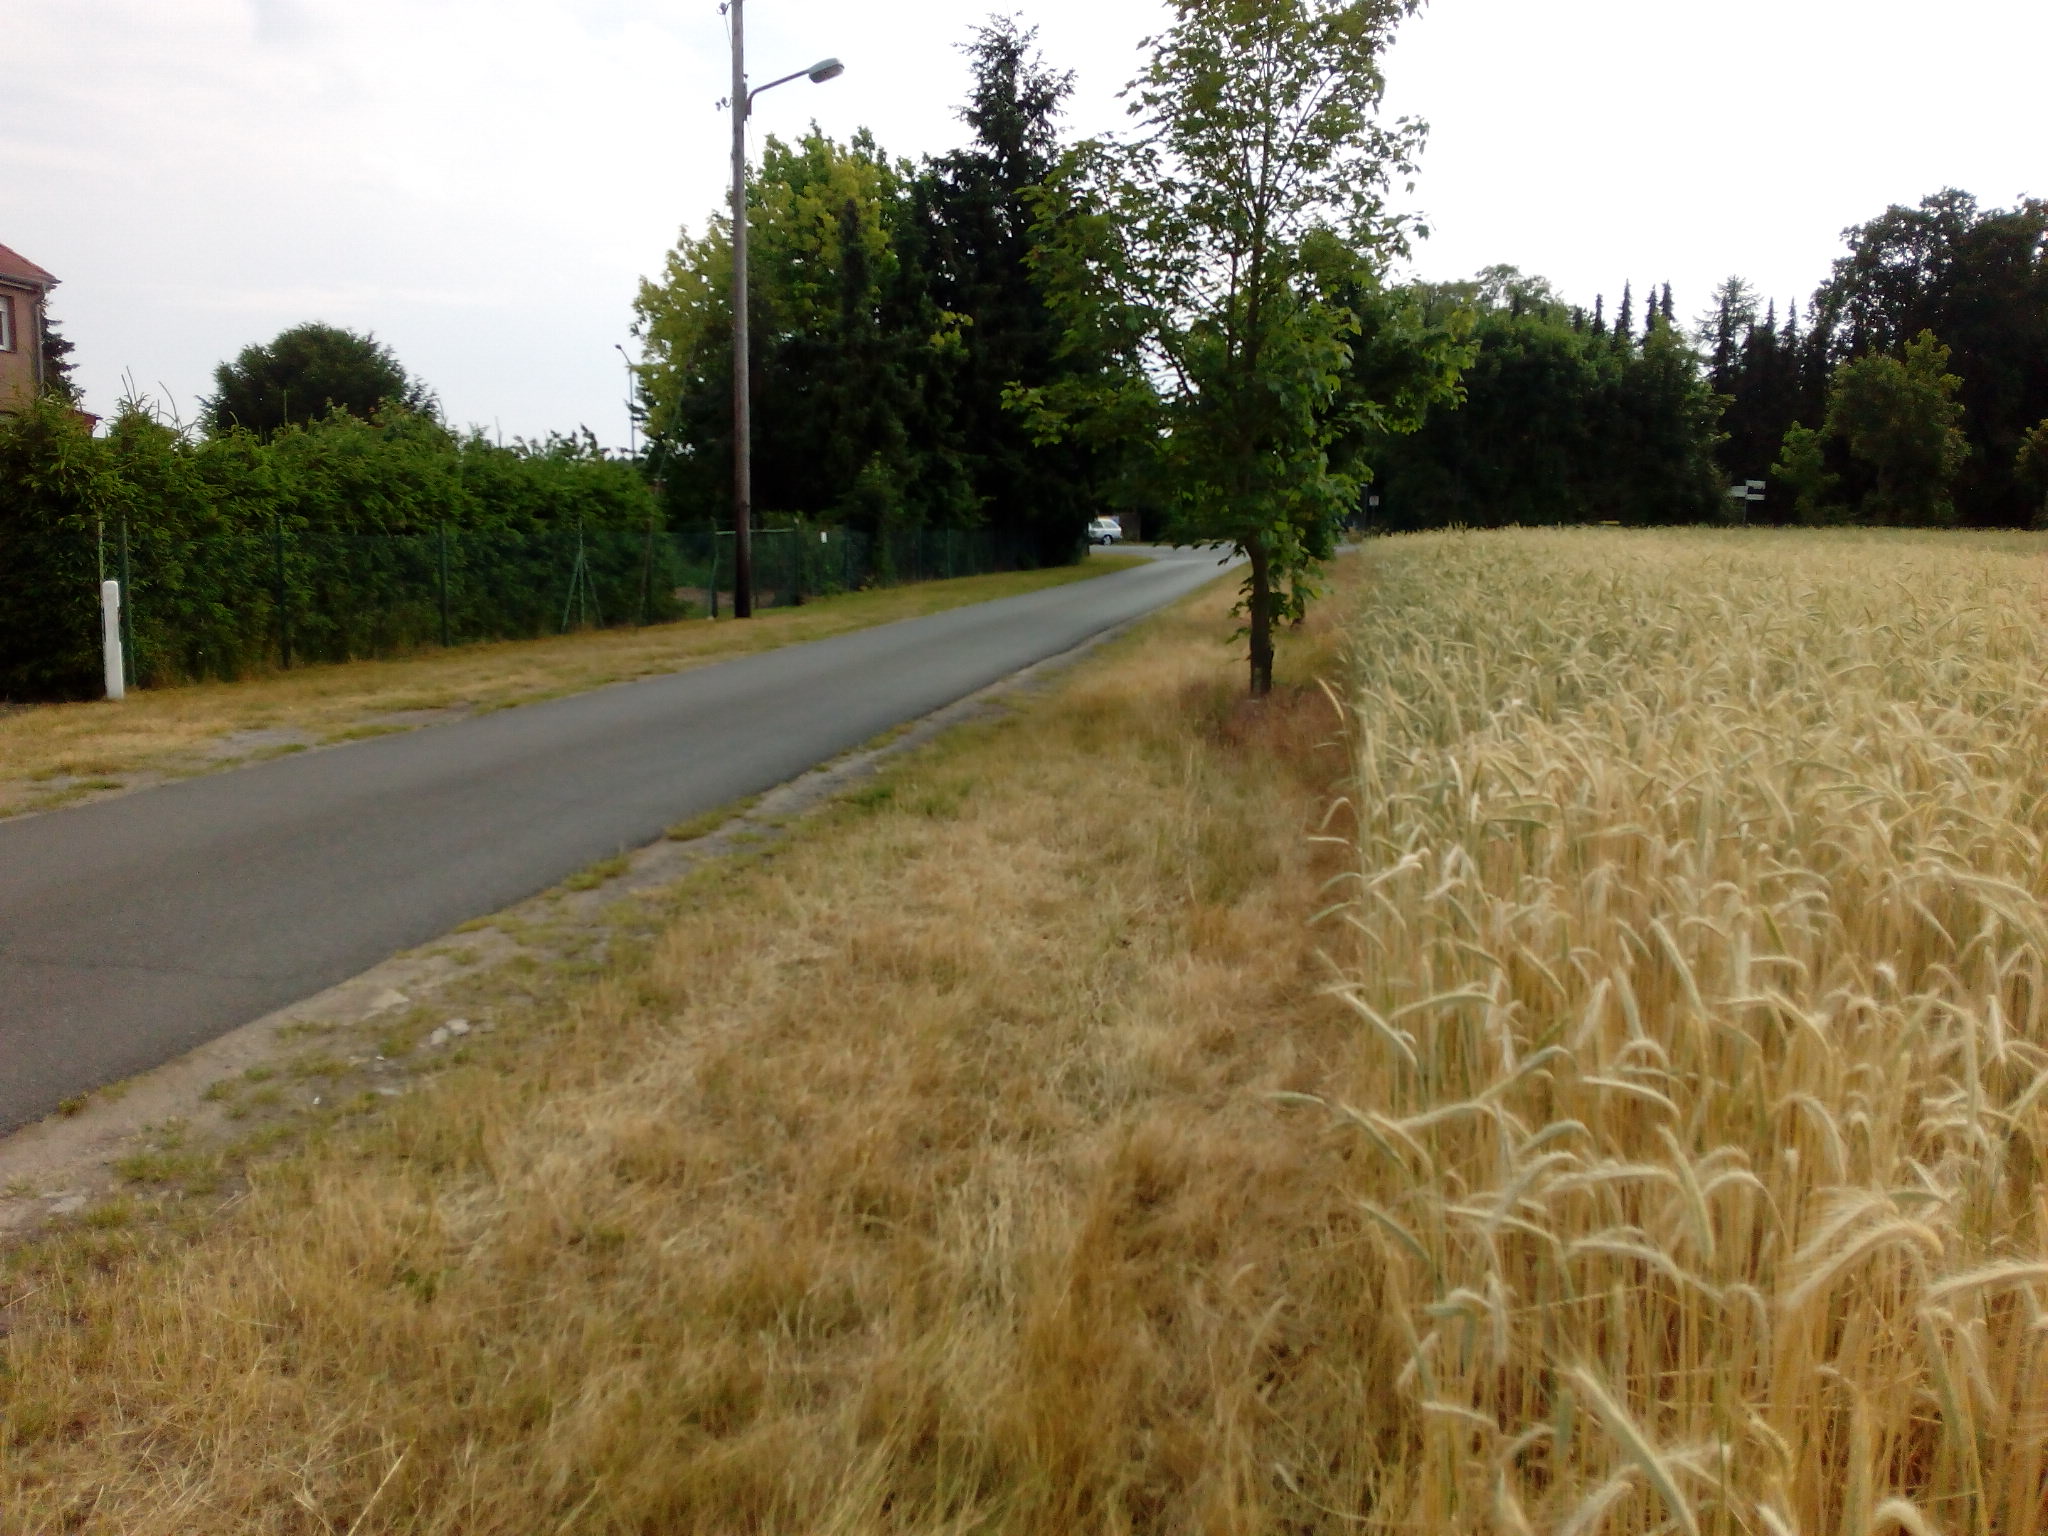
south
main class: Cropland
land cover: Rye
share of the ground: > 75 %
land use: Agriculture (excluding fallow land and kitchen gardens)
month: June
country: DE
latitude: 52.6470
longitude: 9.8670
